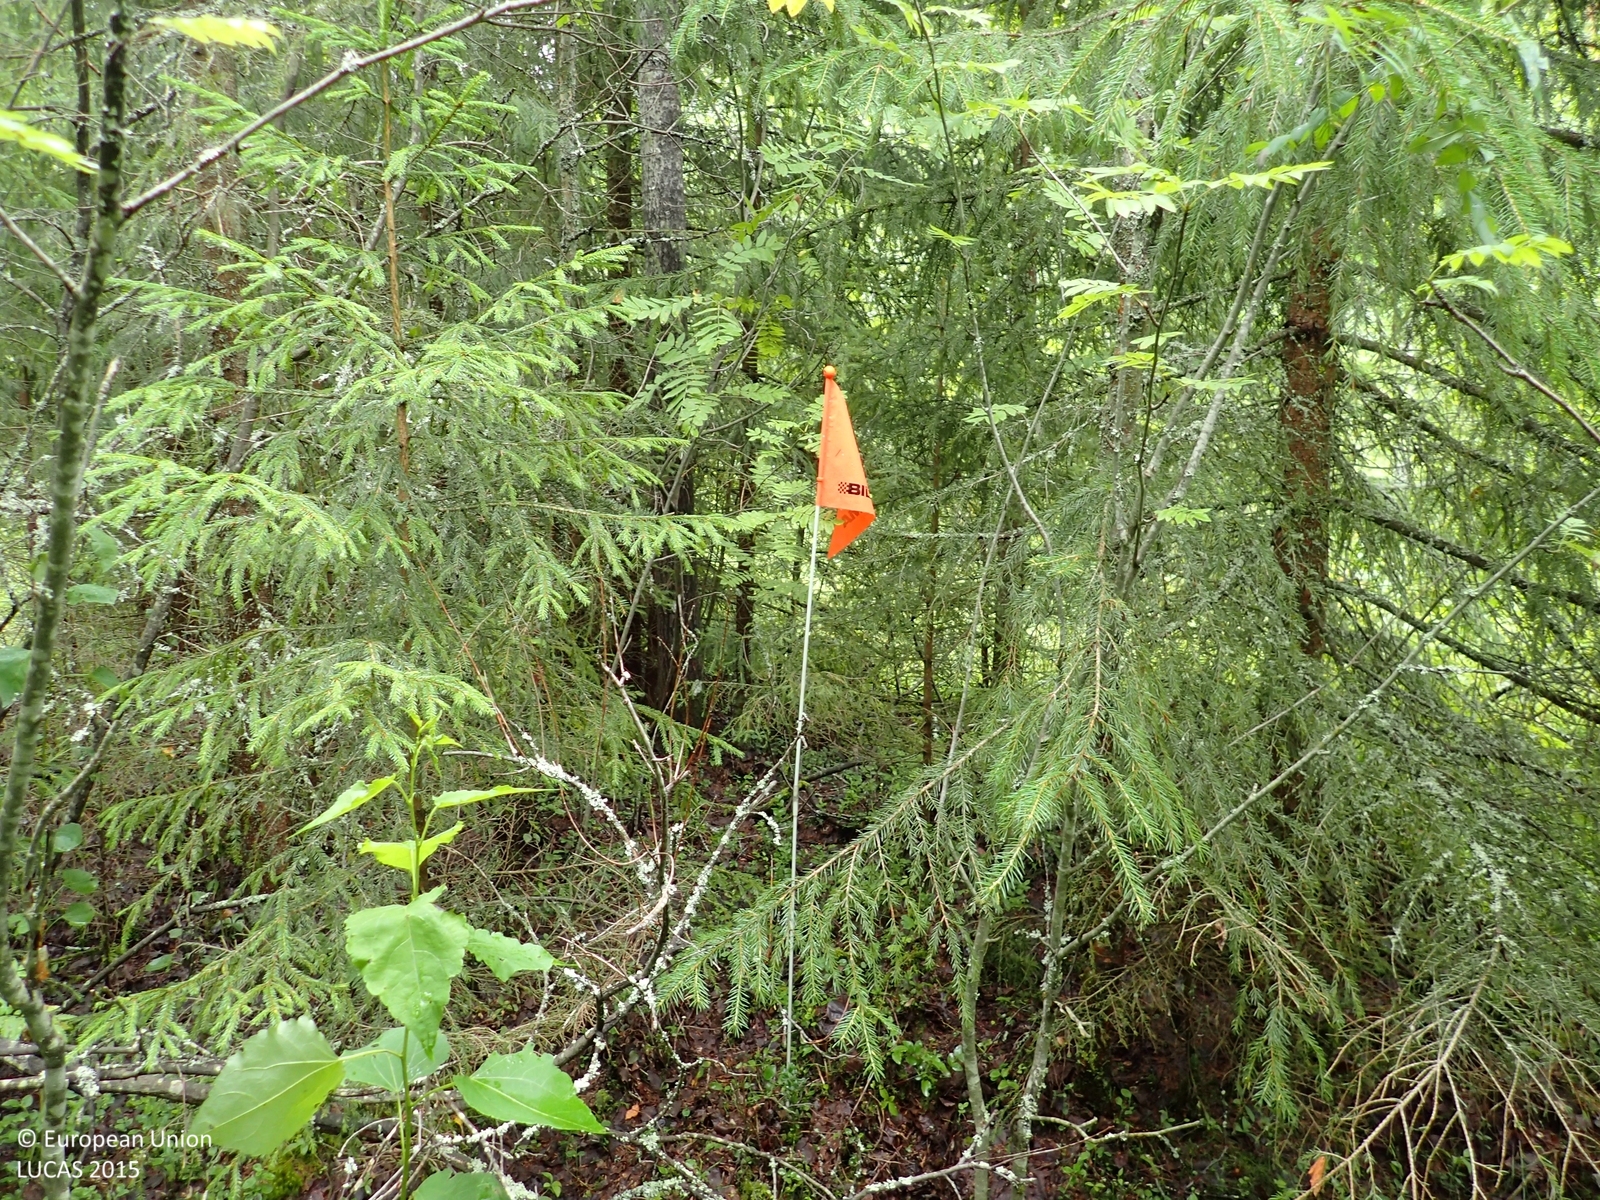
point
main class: Woodland
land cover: Spruce dominated mixed woodland
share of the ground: > 75 %
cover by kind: broadleaved forest trees 60 %, coniferous forest trees 20 %, shrubs 10 %, herbaceous plants 5 %, lichens and mosses 5 %
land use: Forestry
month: July
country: FI
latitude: 62.9387
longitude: 22.8438
